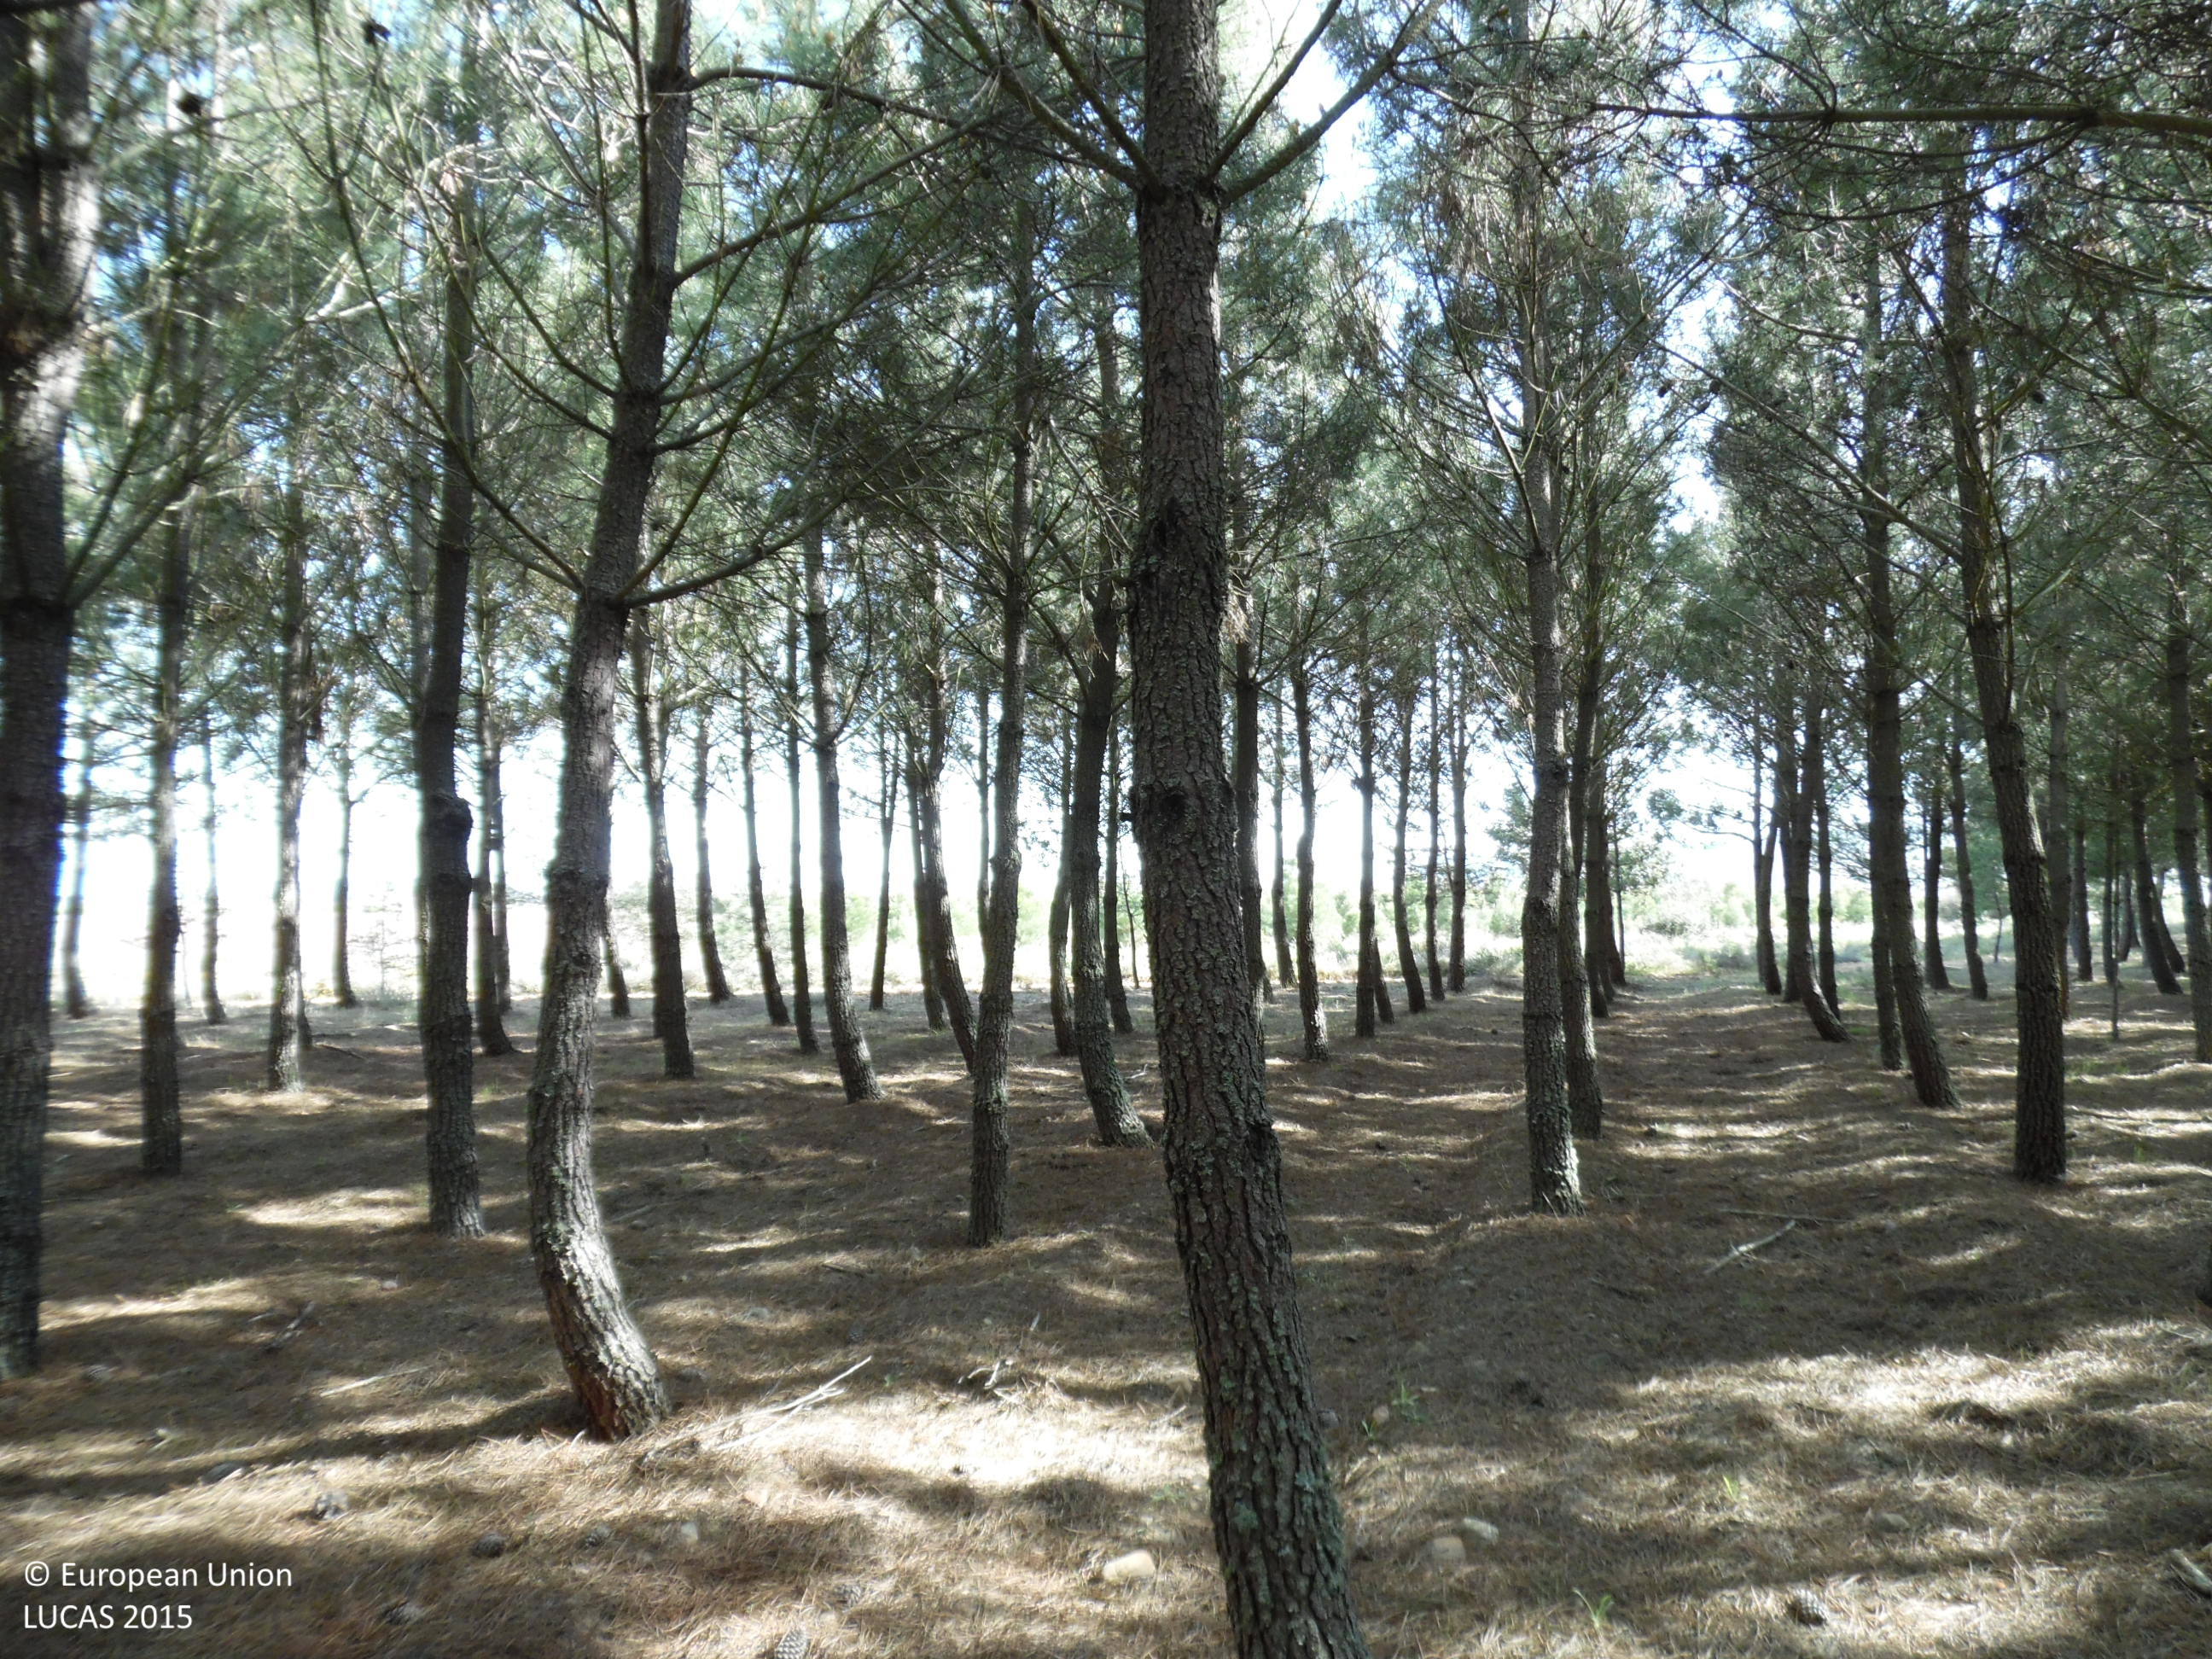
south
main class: Woodland
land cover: Pine dominated coniferous woodland
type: coniferous forest of the mediterranean region
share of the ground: > 75 %
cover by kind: coniferous forest trees 100 %
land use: Forestry
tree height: > 5 m
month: April
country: ES
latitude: 42.2403
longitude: -6.0880
